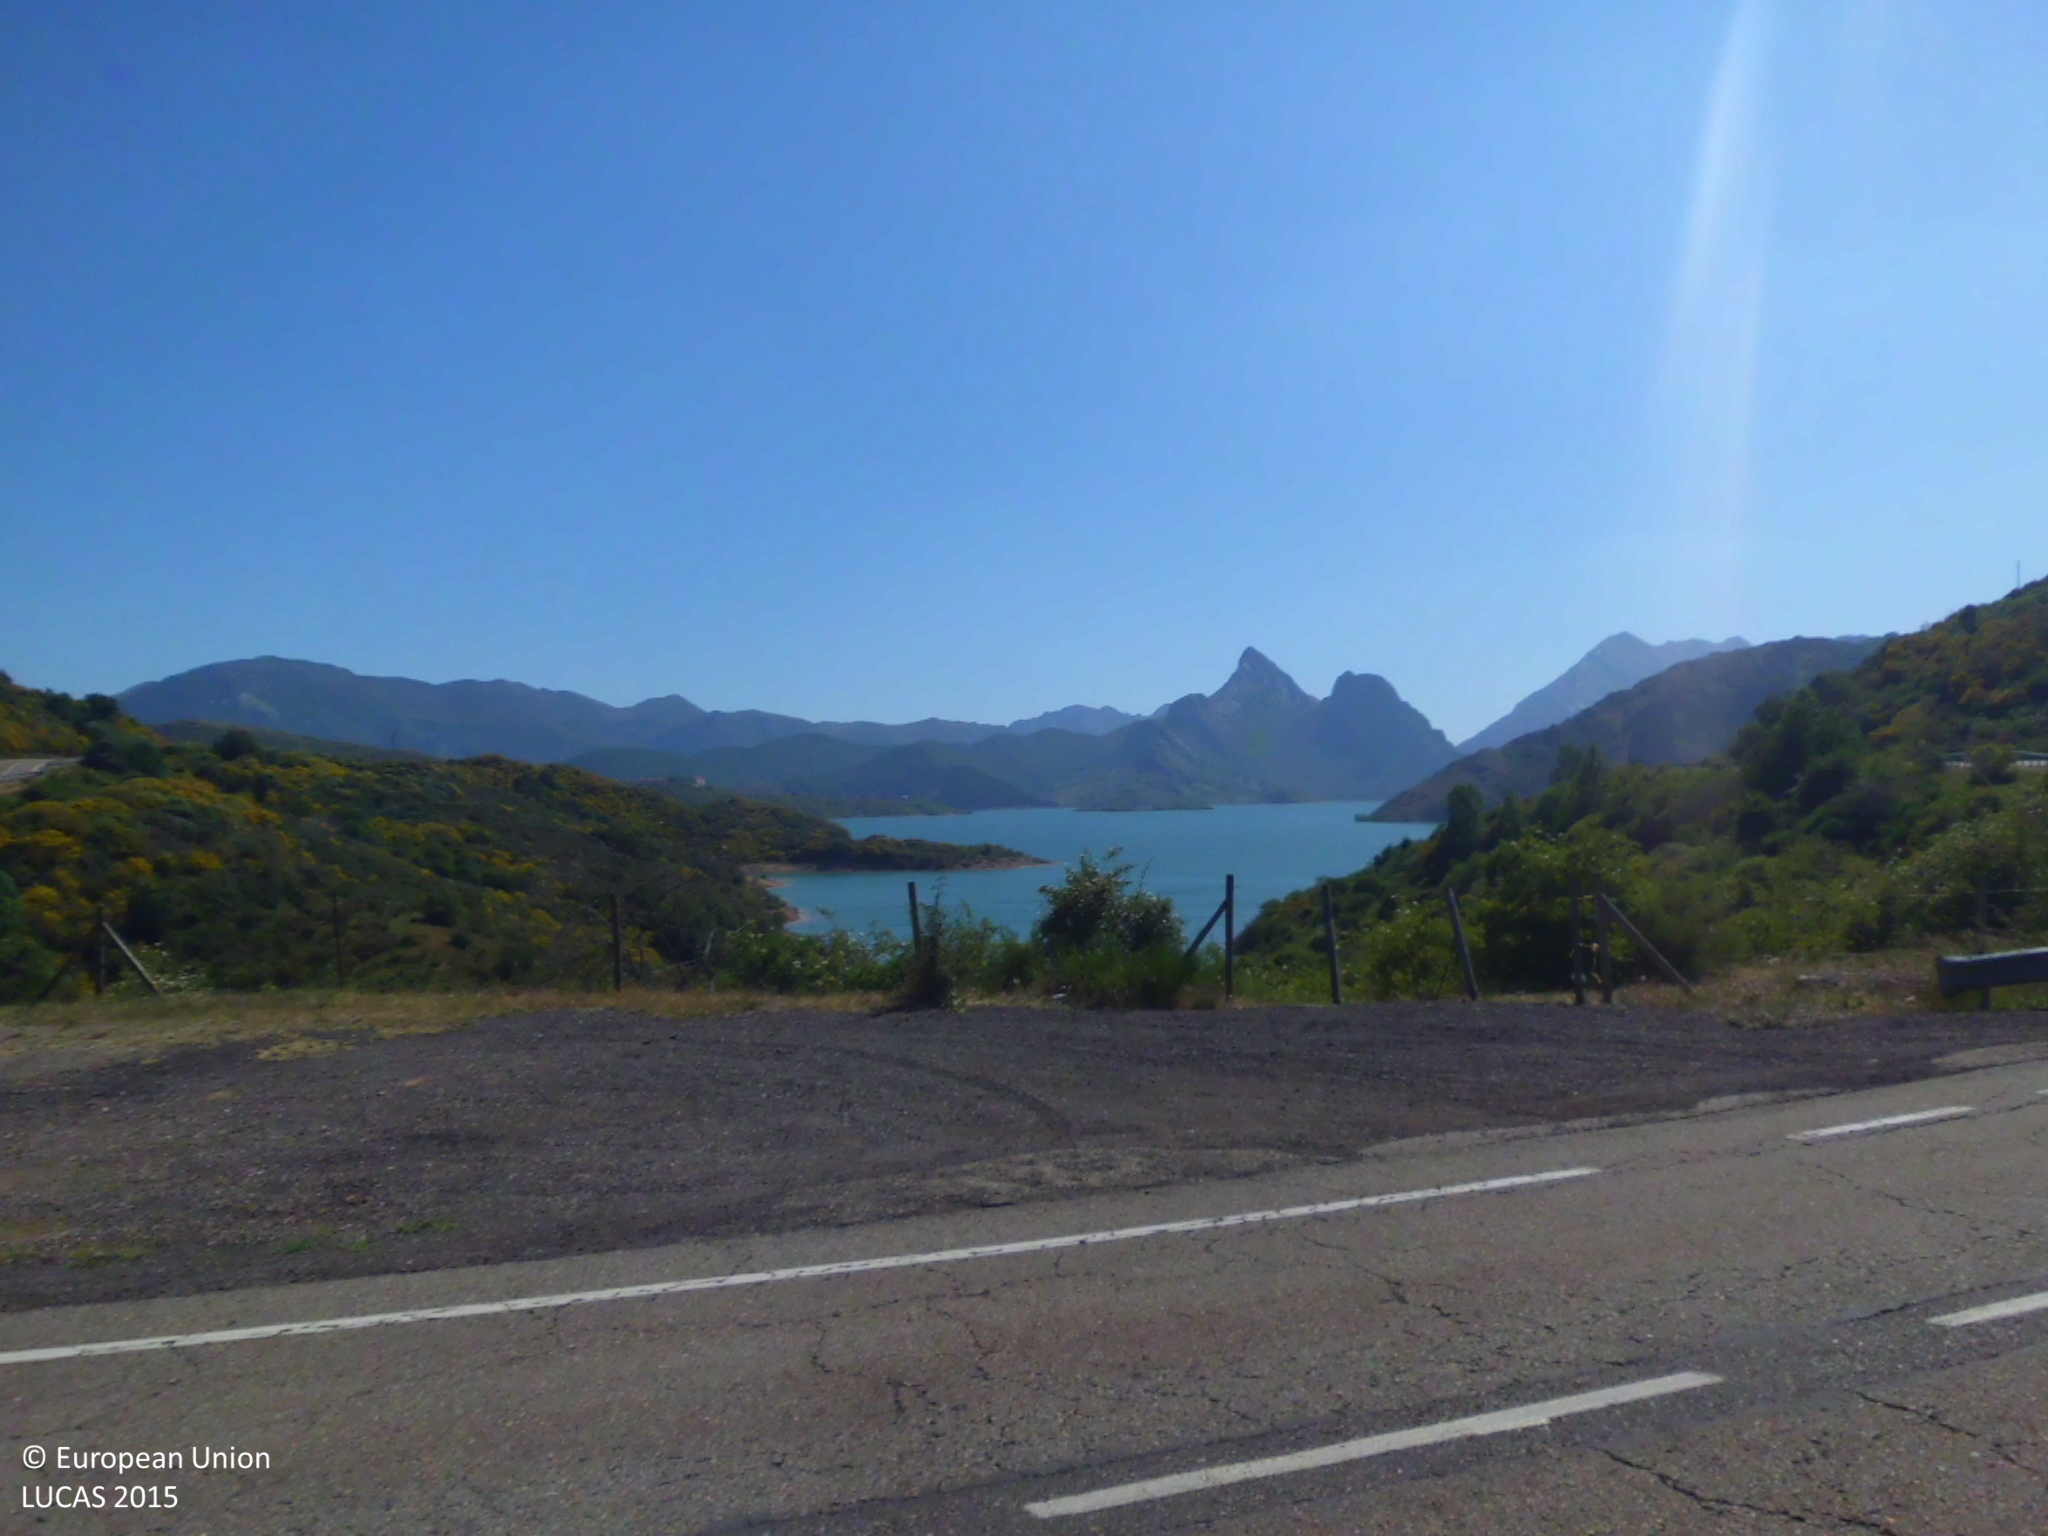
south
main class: Shrubland
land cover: Shrubland with sparse tree cover
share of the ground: > 75 %
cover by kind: shrubs 75 %, herbaceous plants 20 %, broadleaved forest trees 5 %
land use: Agriculture (excluding fallow land and kitchen gardens)
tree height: < 5 m
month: June
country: ES
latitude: 42.9973
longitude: -4.9936
